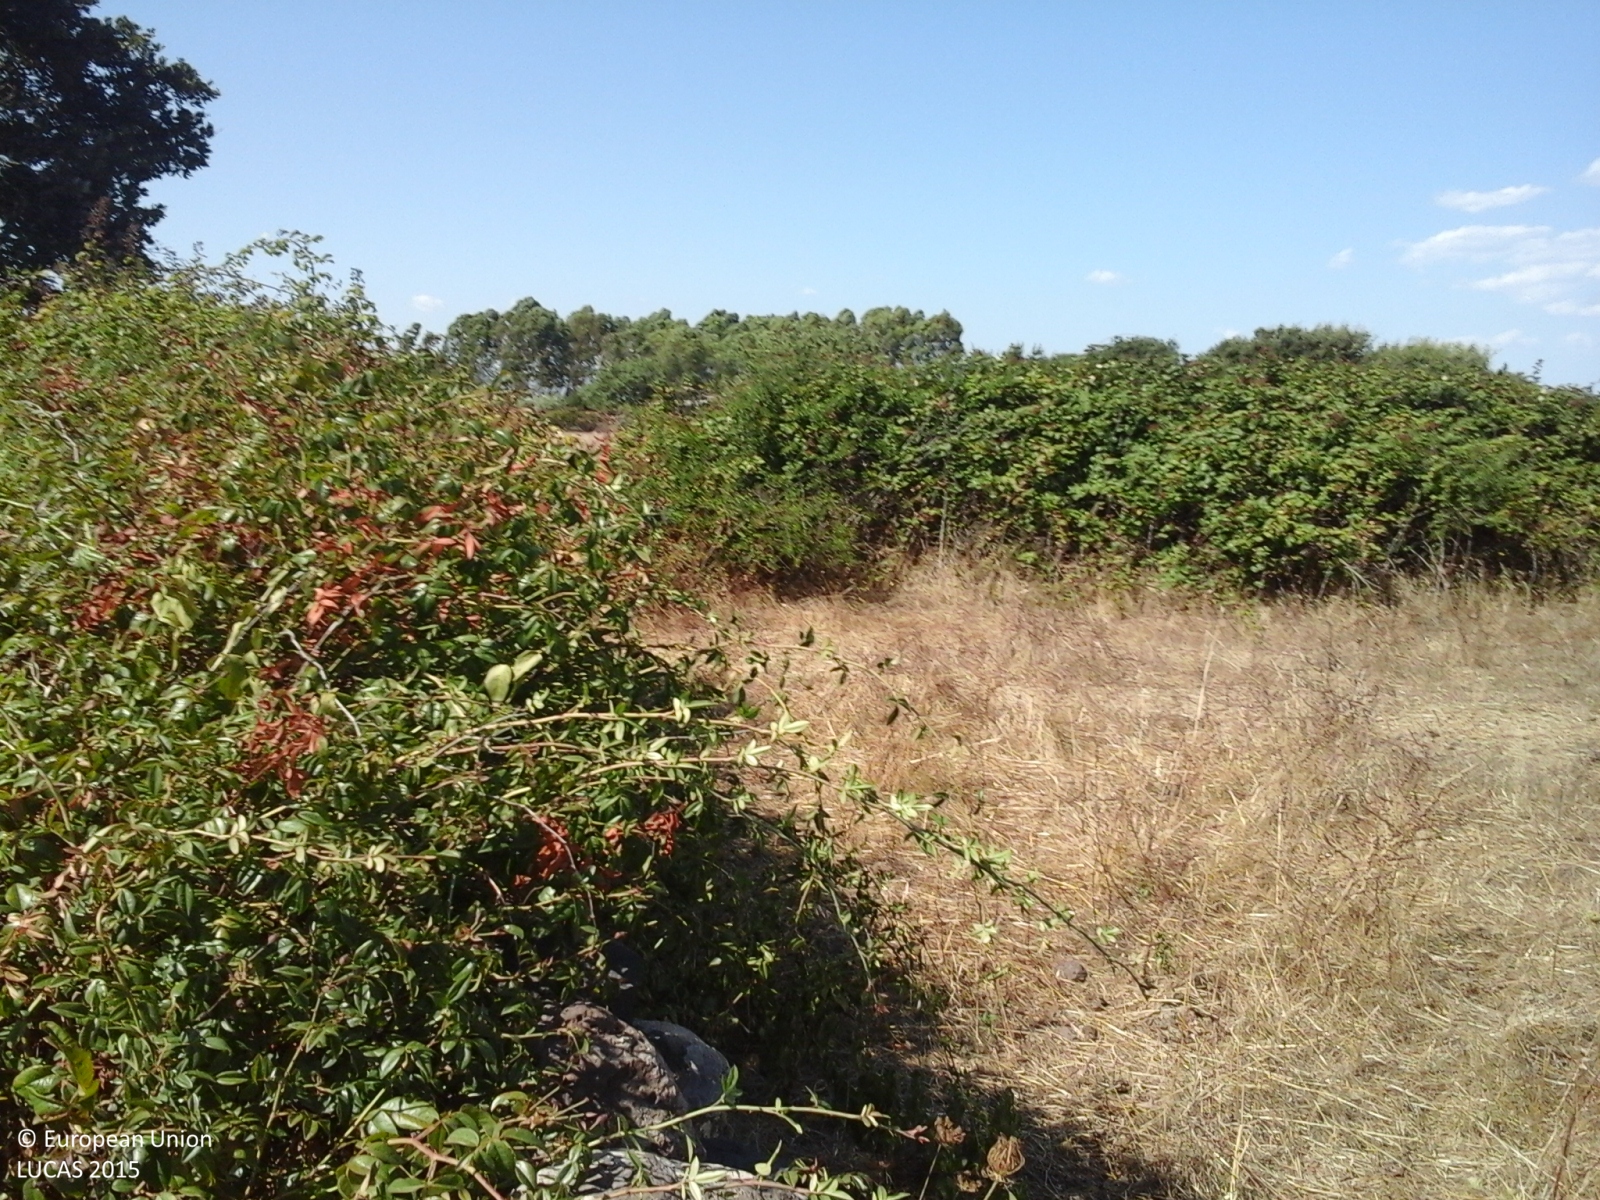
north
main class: Grassland
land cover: Grassland without tree/shrub cover
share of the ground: > 75 %
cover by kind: herbaceous plants 100 %
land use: Agriculture (excluding fallow land and kitchen gardens)
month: August
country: IT
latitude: 40.1335
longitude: 8.8210
